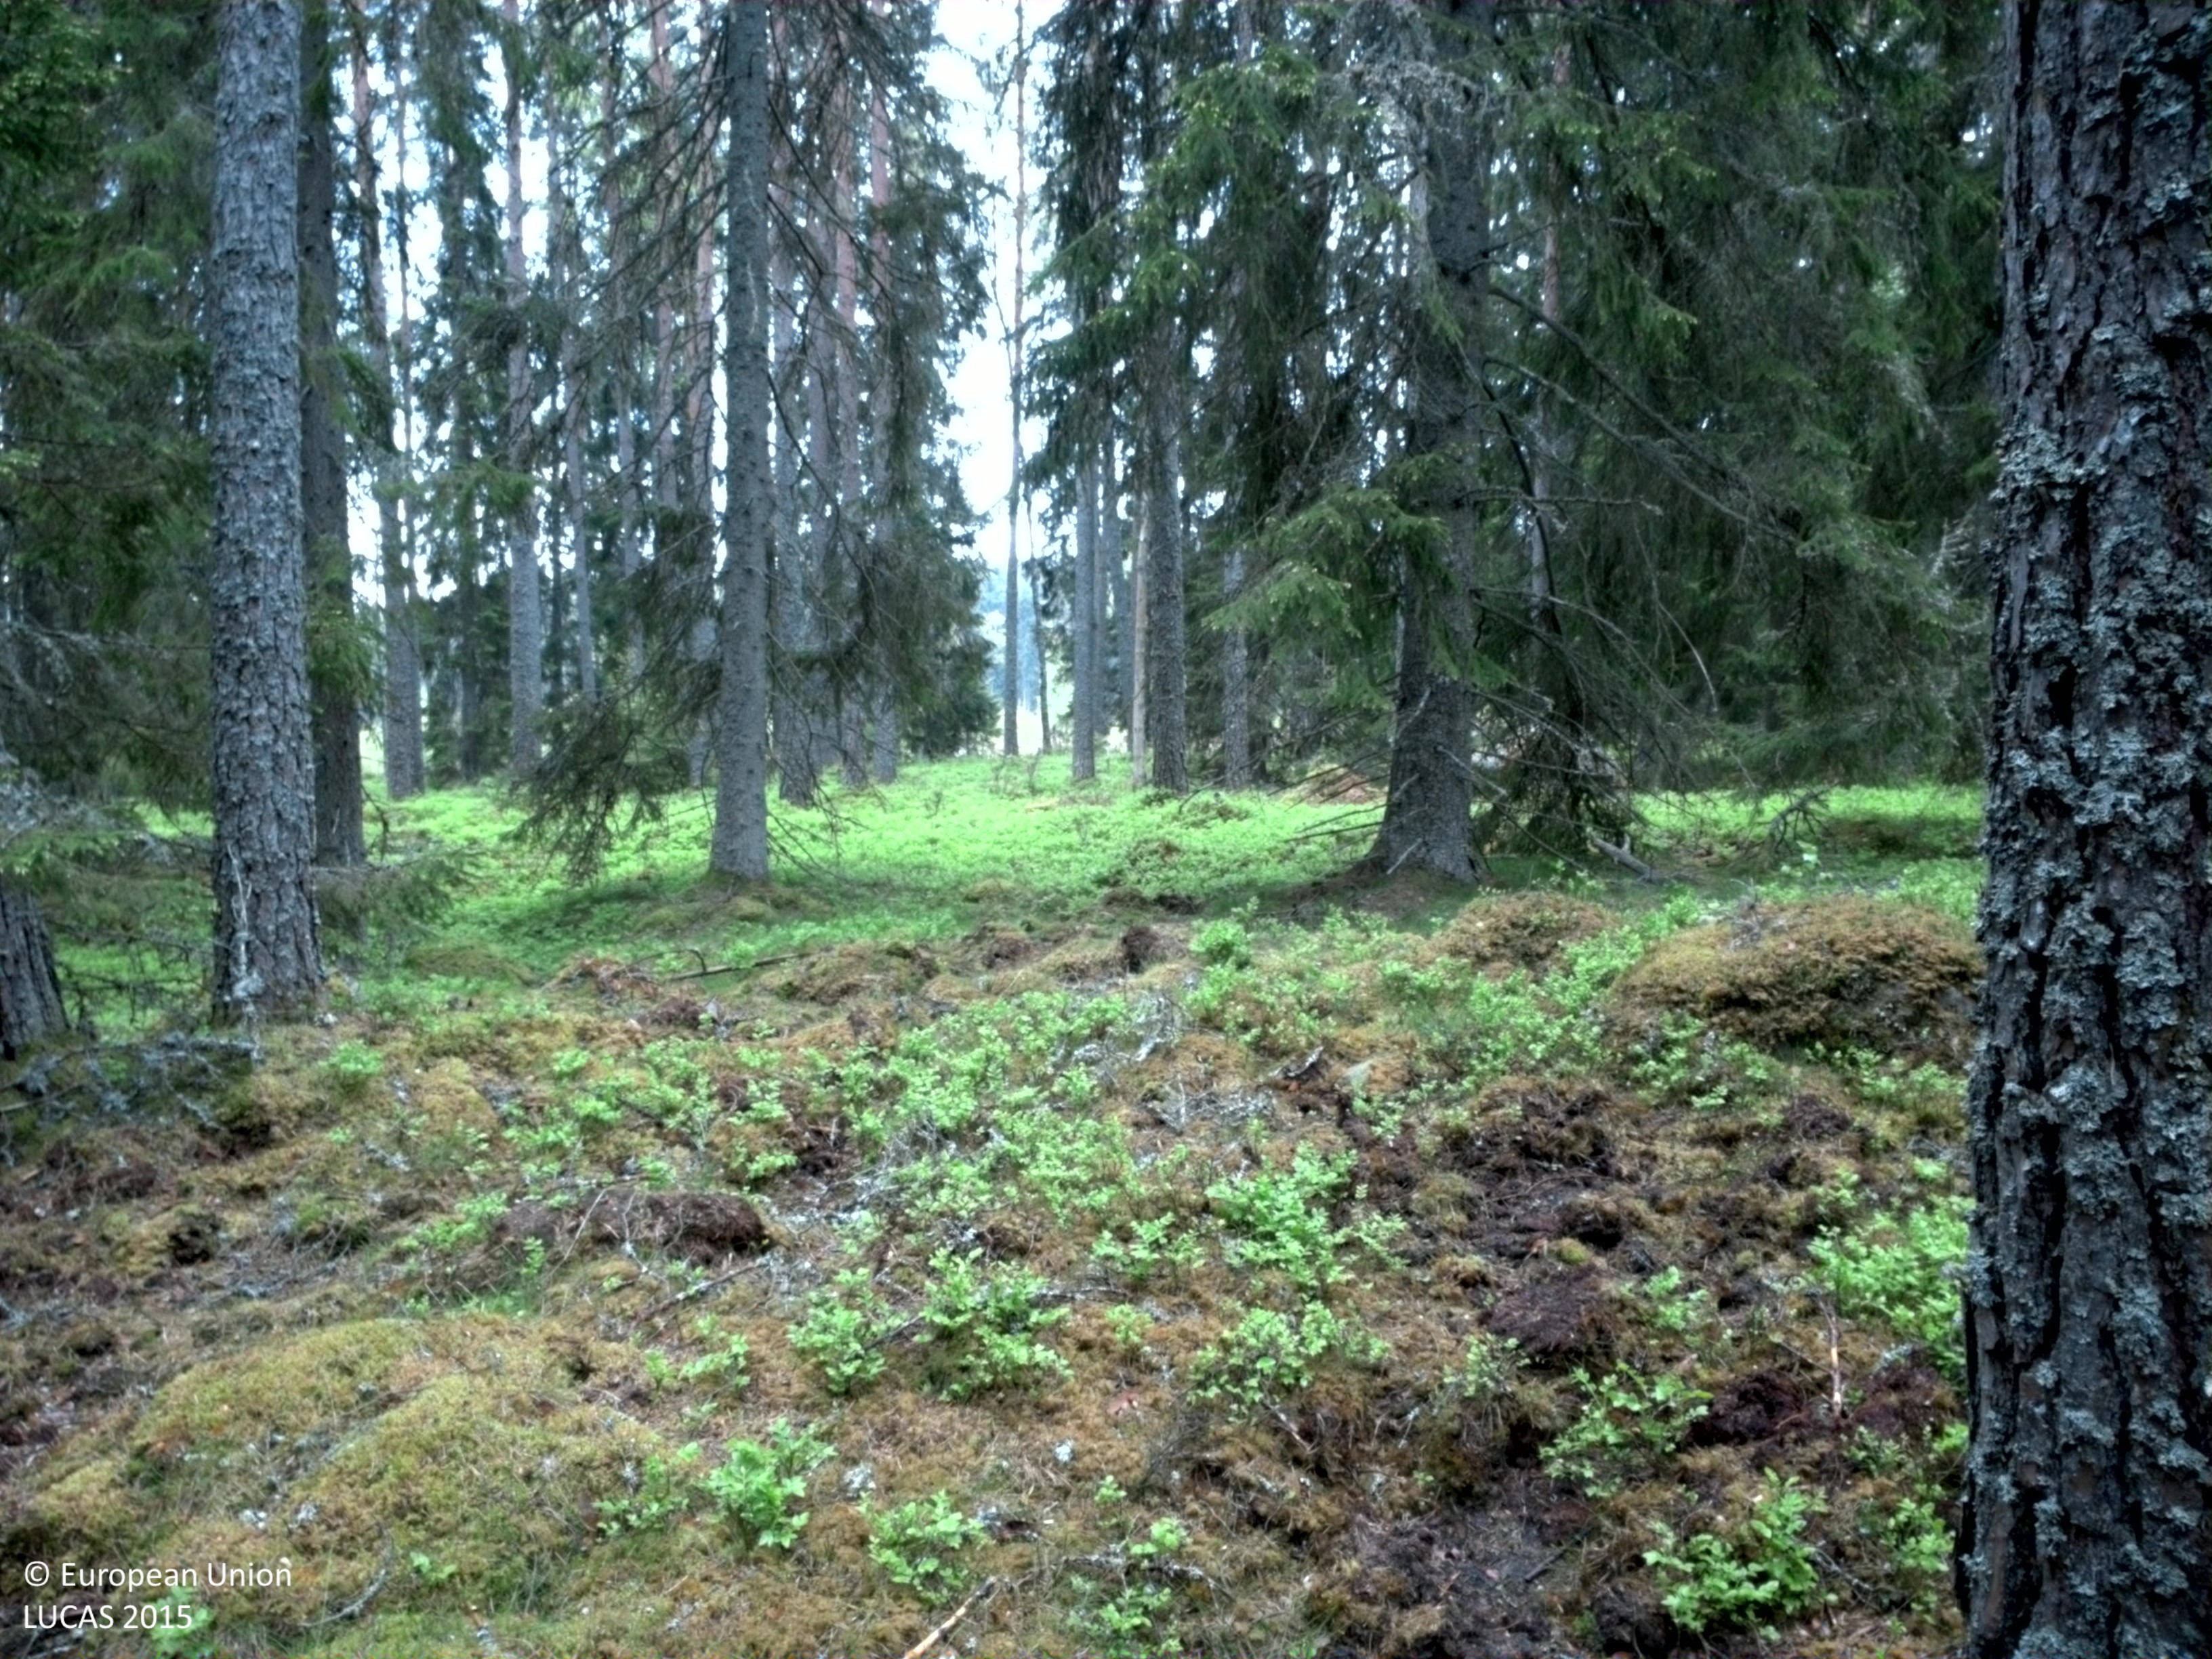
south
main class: Woodland
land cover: Pine dominated coniferous woodland
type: boreal forest
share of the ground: 50 - 75 %
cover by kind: coniferous forest trees 50 %, shrubs 25 %, lichens and mosses 25 %
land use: Forestry
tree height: > 5 m
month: May
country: SE
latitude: 57.4462
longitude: 15.3454
